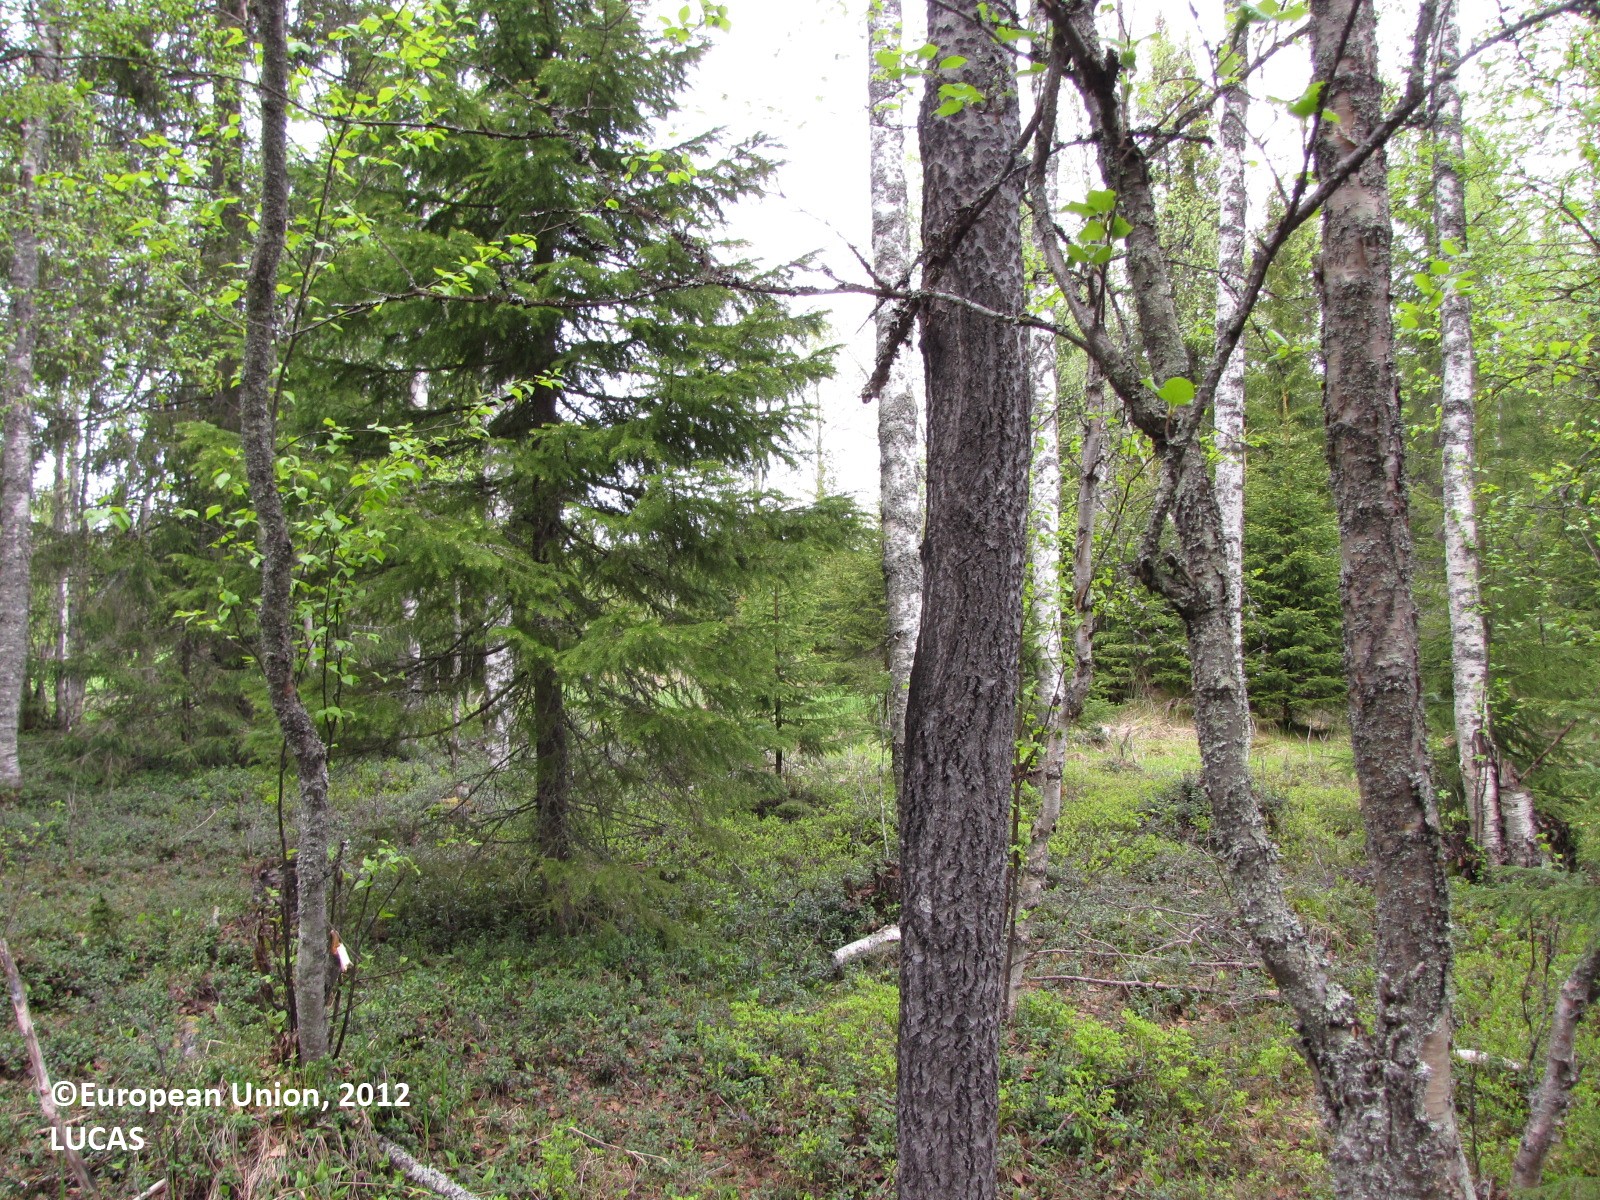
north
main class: Woodland
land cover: Spruce dominated mixed woodland
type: boreal forest
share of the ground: 50 - 75 %
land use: Forestry
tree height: > 5 m
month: June
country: FI
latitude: 65.8990
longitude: 24.5602
